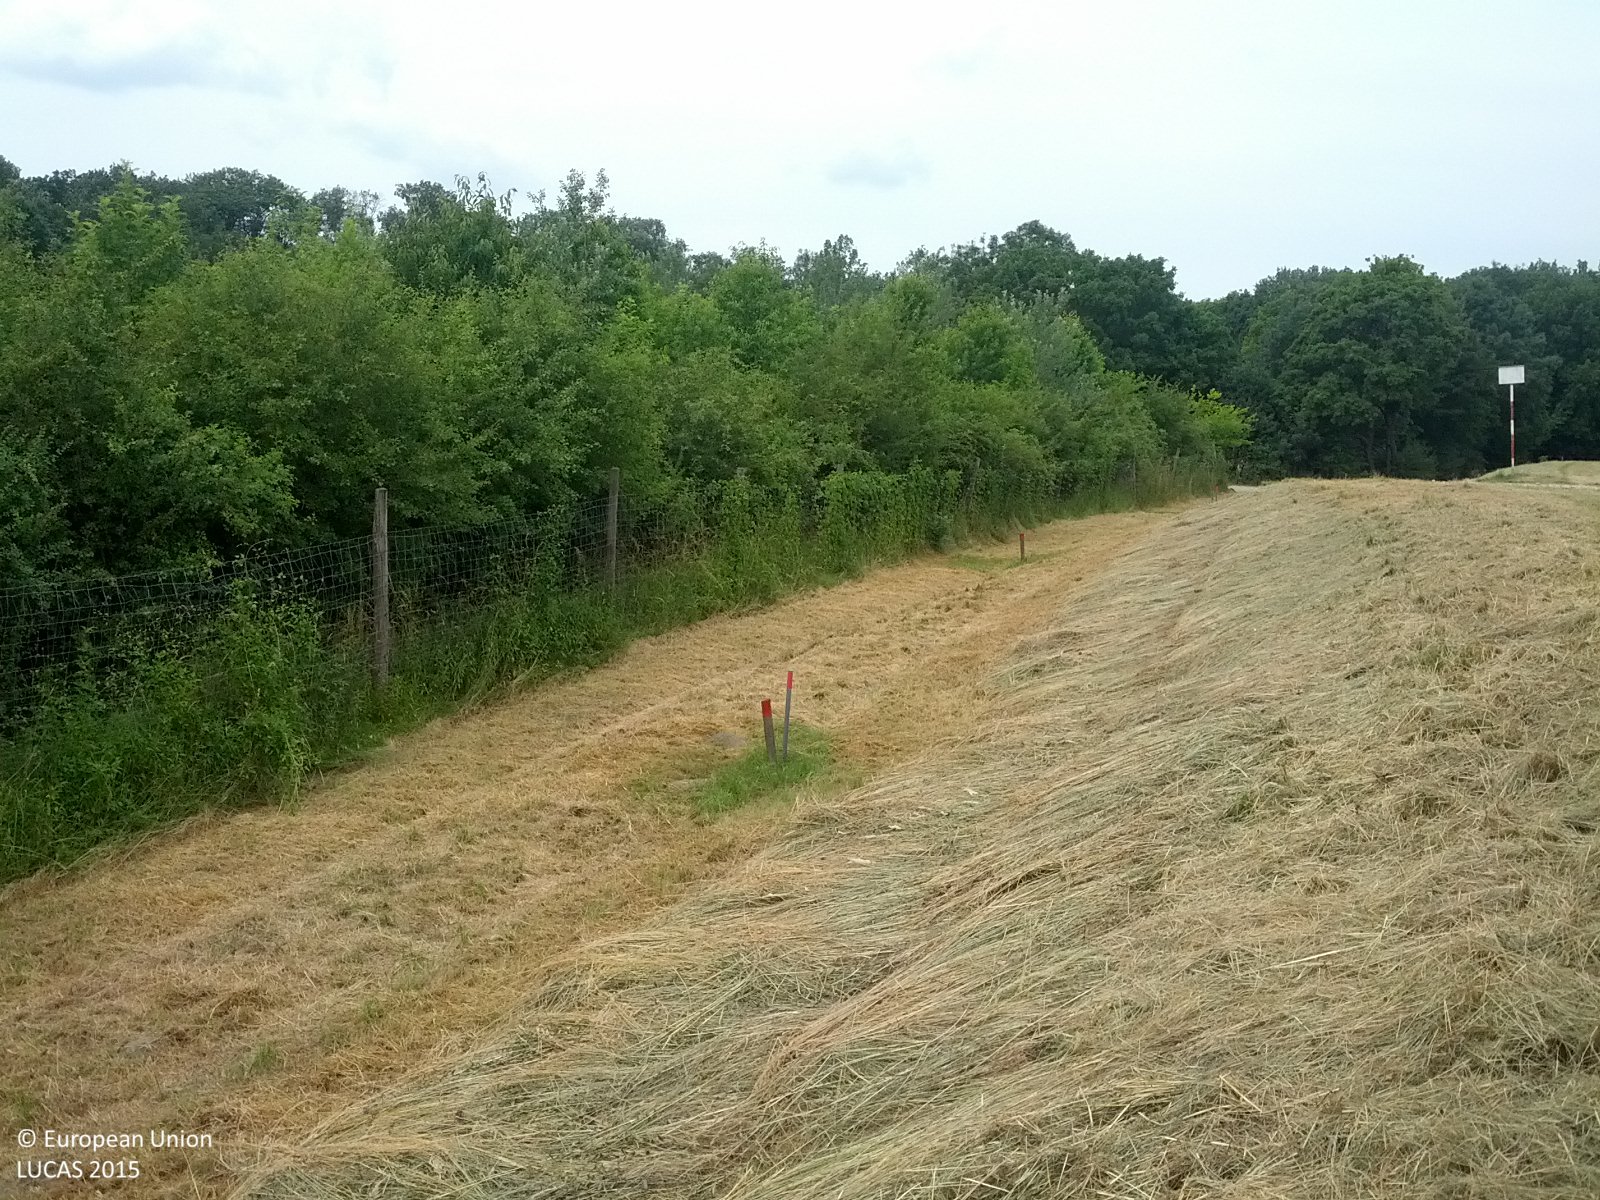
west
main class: Grassland
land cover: Grassland without tree/shrub cover
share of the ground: > 75 %
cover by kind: herbaceous plants 100 %
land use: Protection infrastructures
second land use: Agriculture (excluding fallow land and kitchen gardens)
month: June
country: AT
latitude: 48.1534
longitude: 16.5790
